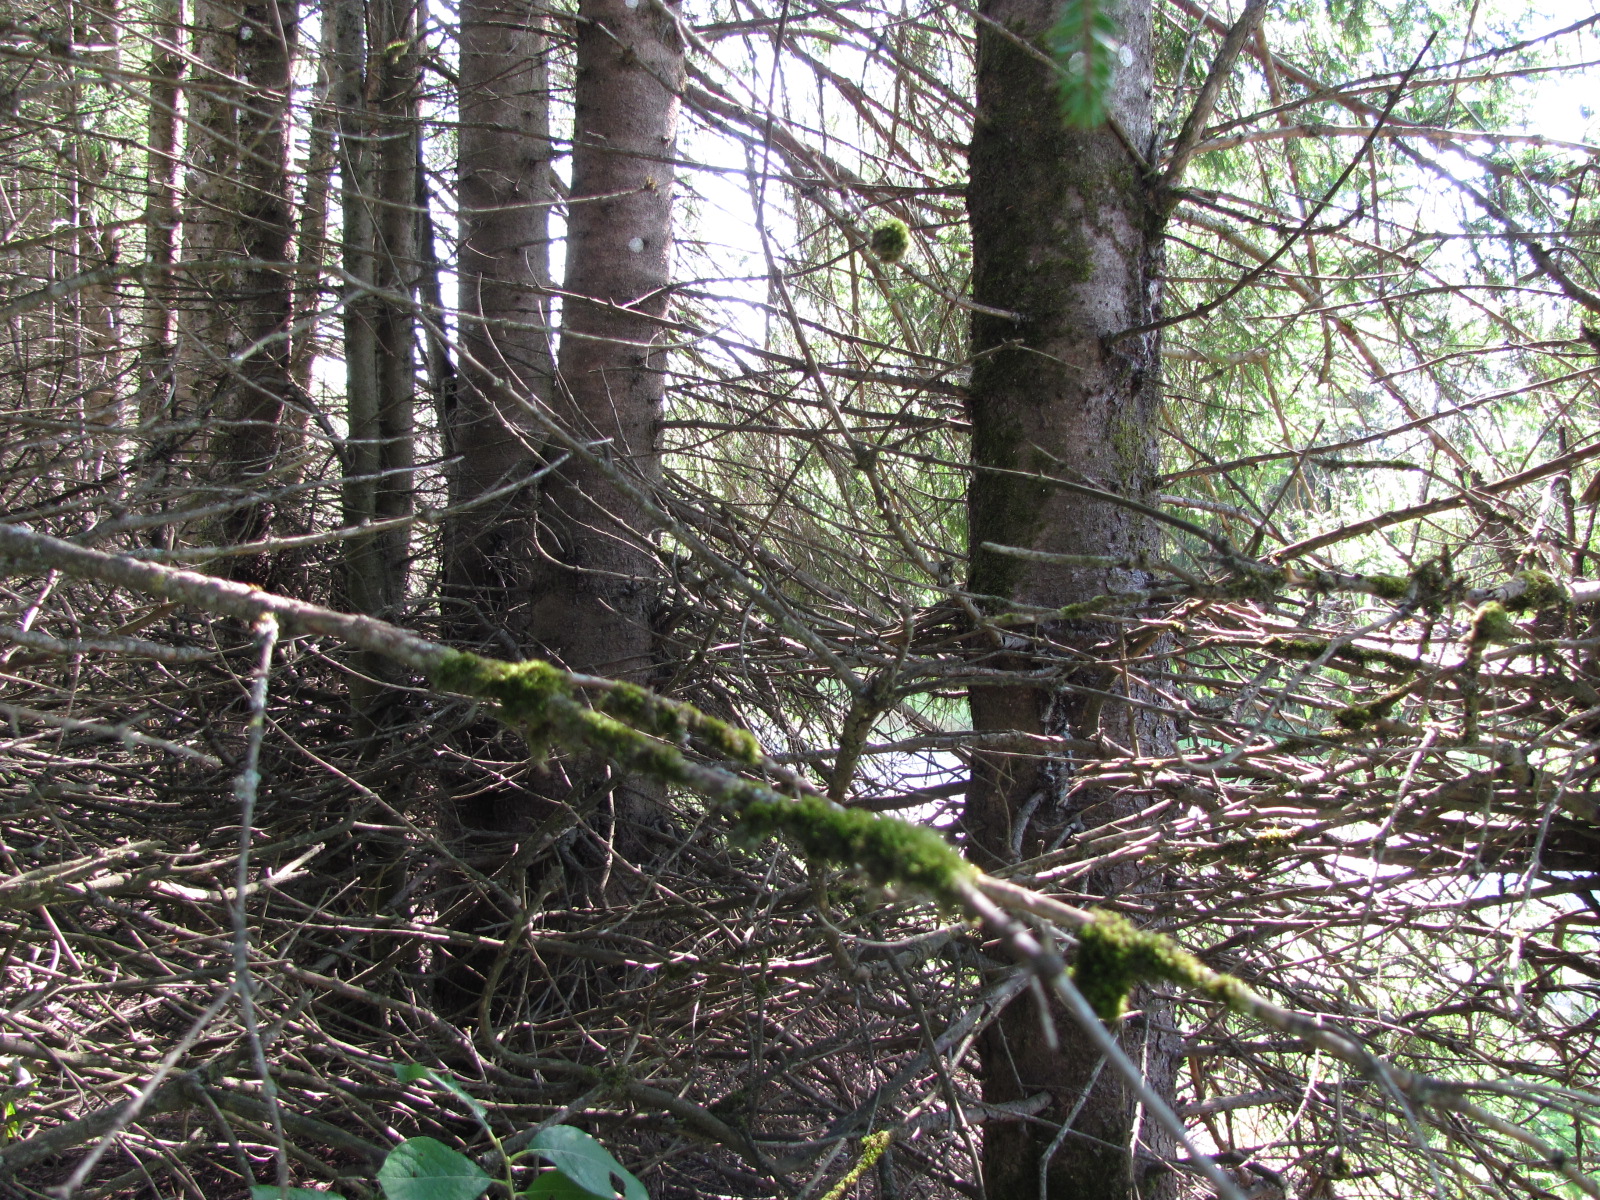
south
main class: Woodland
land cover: Spruce dominated coniferous woodland
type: hemiboreal forest and nemoral coniferous forest and mixed broadleaved-coniferous forest
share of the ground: > 75 %
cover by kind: coniferous forest trees 80 %, herbaceous plants 15 %, broadleaved forest trees 5 %
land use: Road transport
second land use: Agriculture (excluding fallow land and kitchen gardens)
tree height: > 5 m
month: August
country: LV
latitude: 57.0117
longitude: 25.2451
